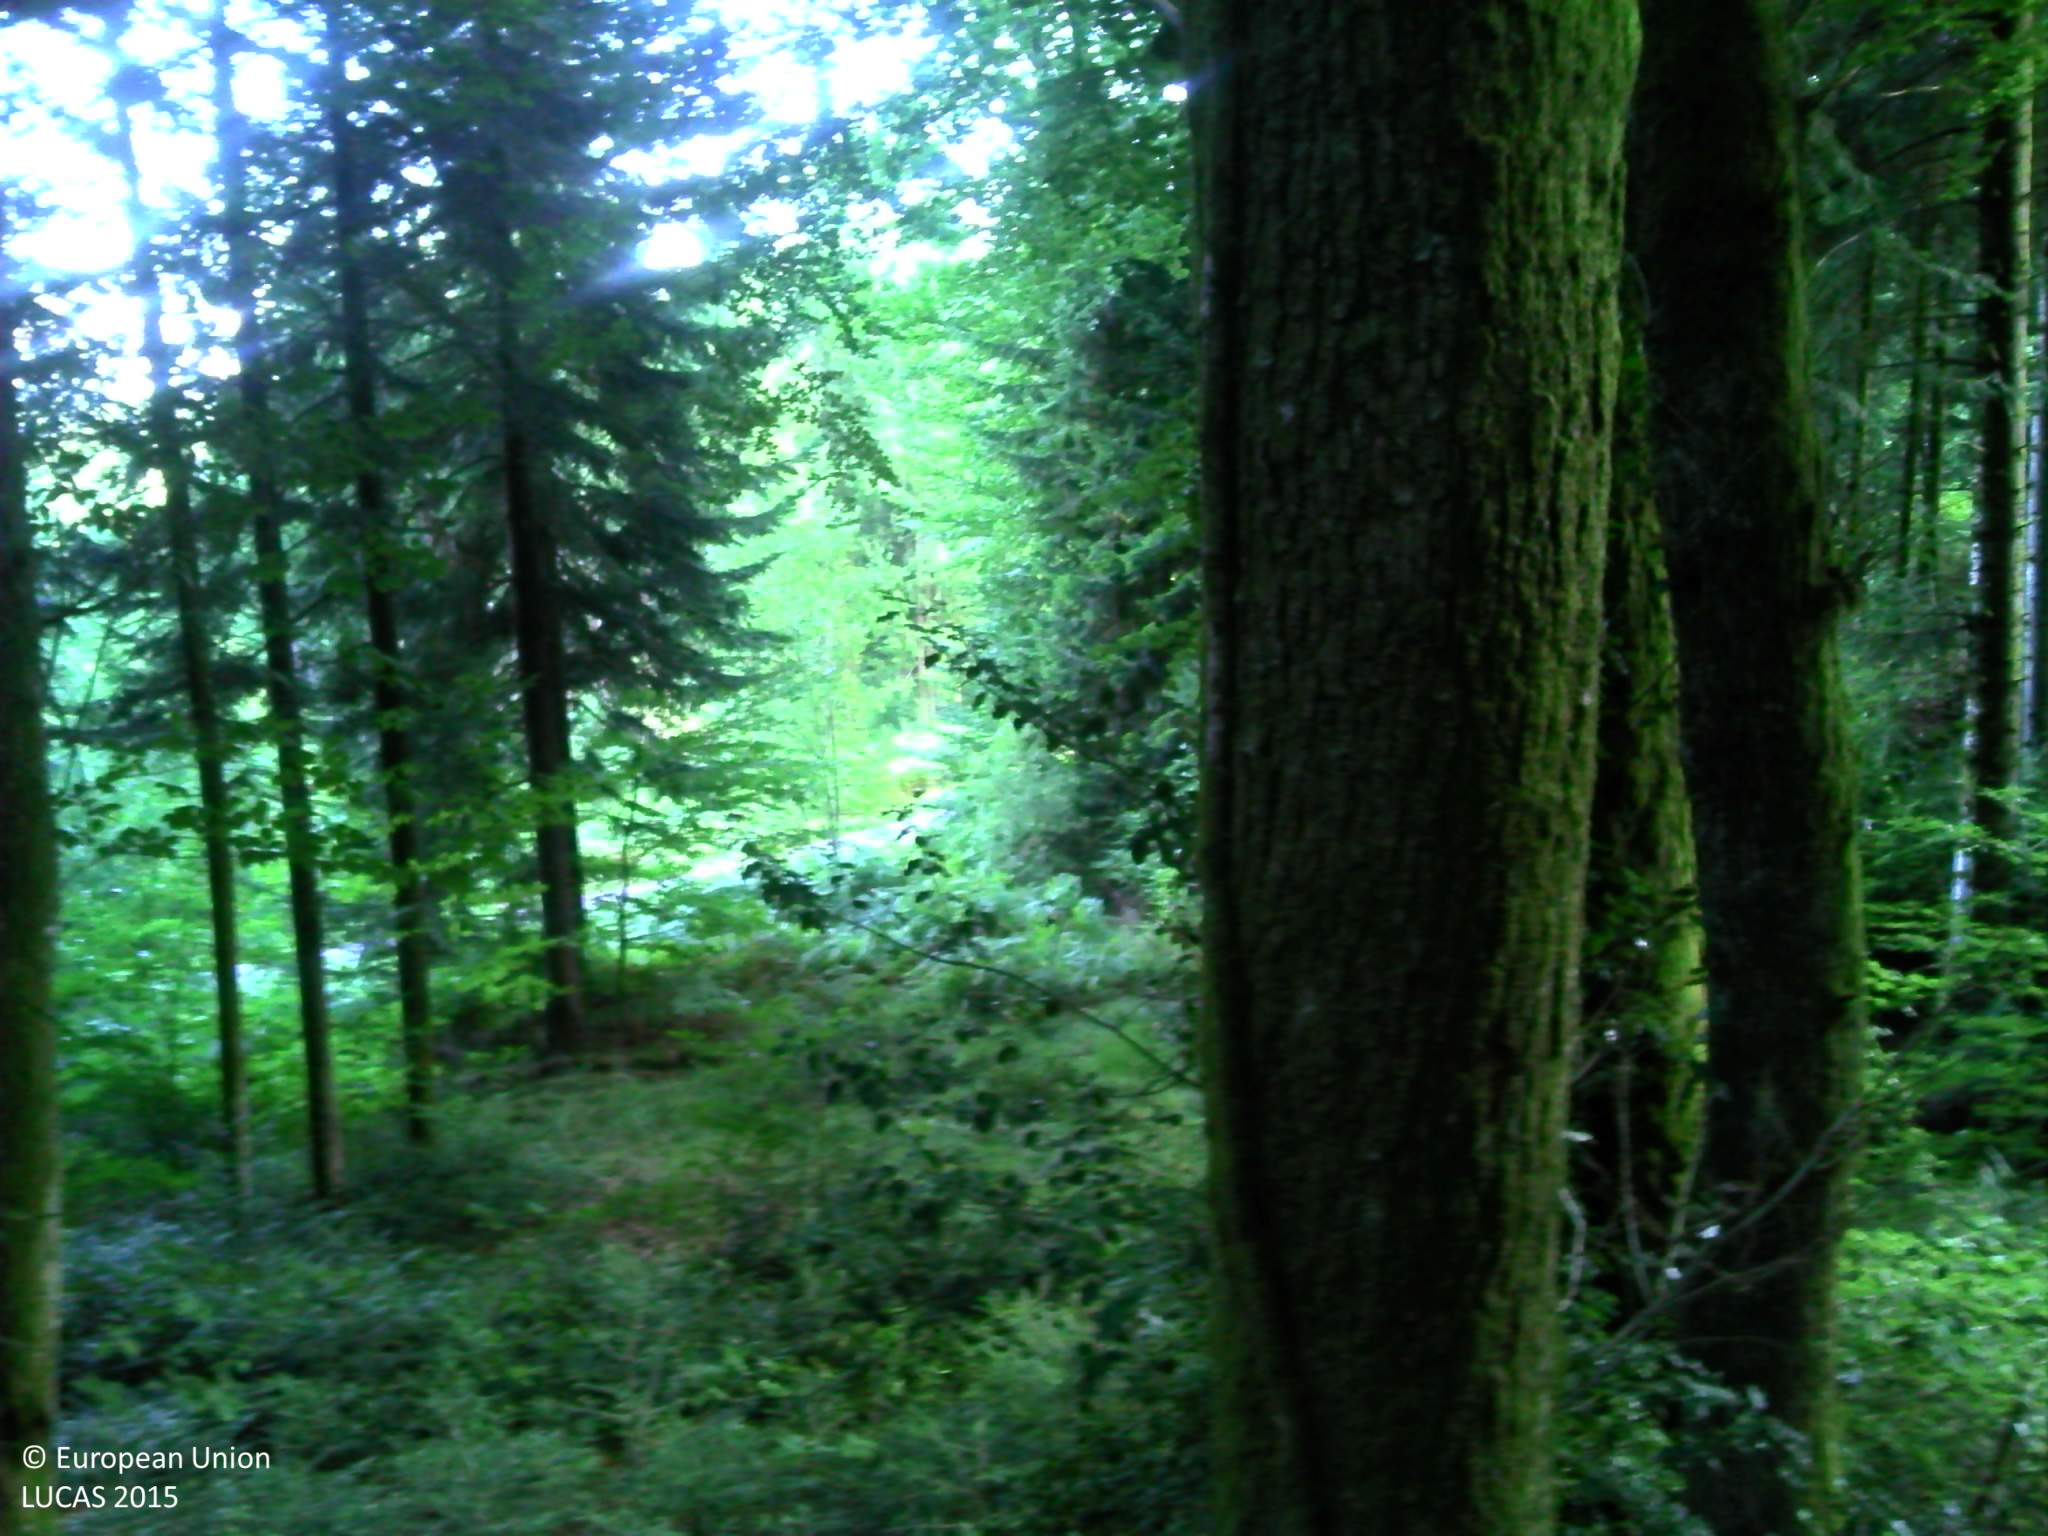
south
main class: Woodland
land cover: Other mixed woodland
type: exotic forest
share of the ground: > 75 %
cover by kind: coniferous forest trees 60 %, broadleaved forest trees 25 %, shrubs 5 %, herbaceous plants 5 %, lichens and mosses 5 %
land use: Forestry
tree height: > 5 m
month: August
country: FR
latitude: 45.8900
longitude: 1.7847
